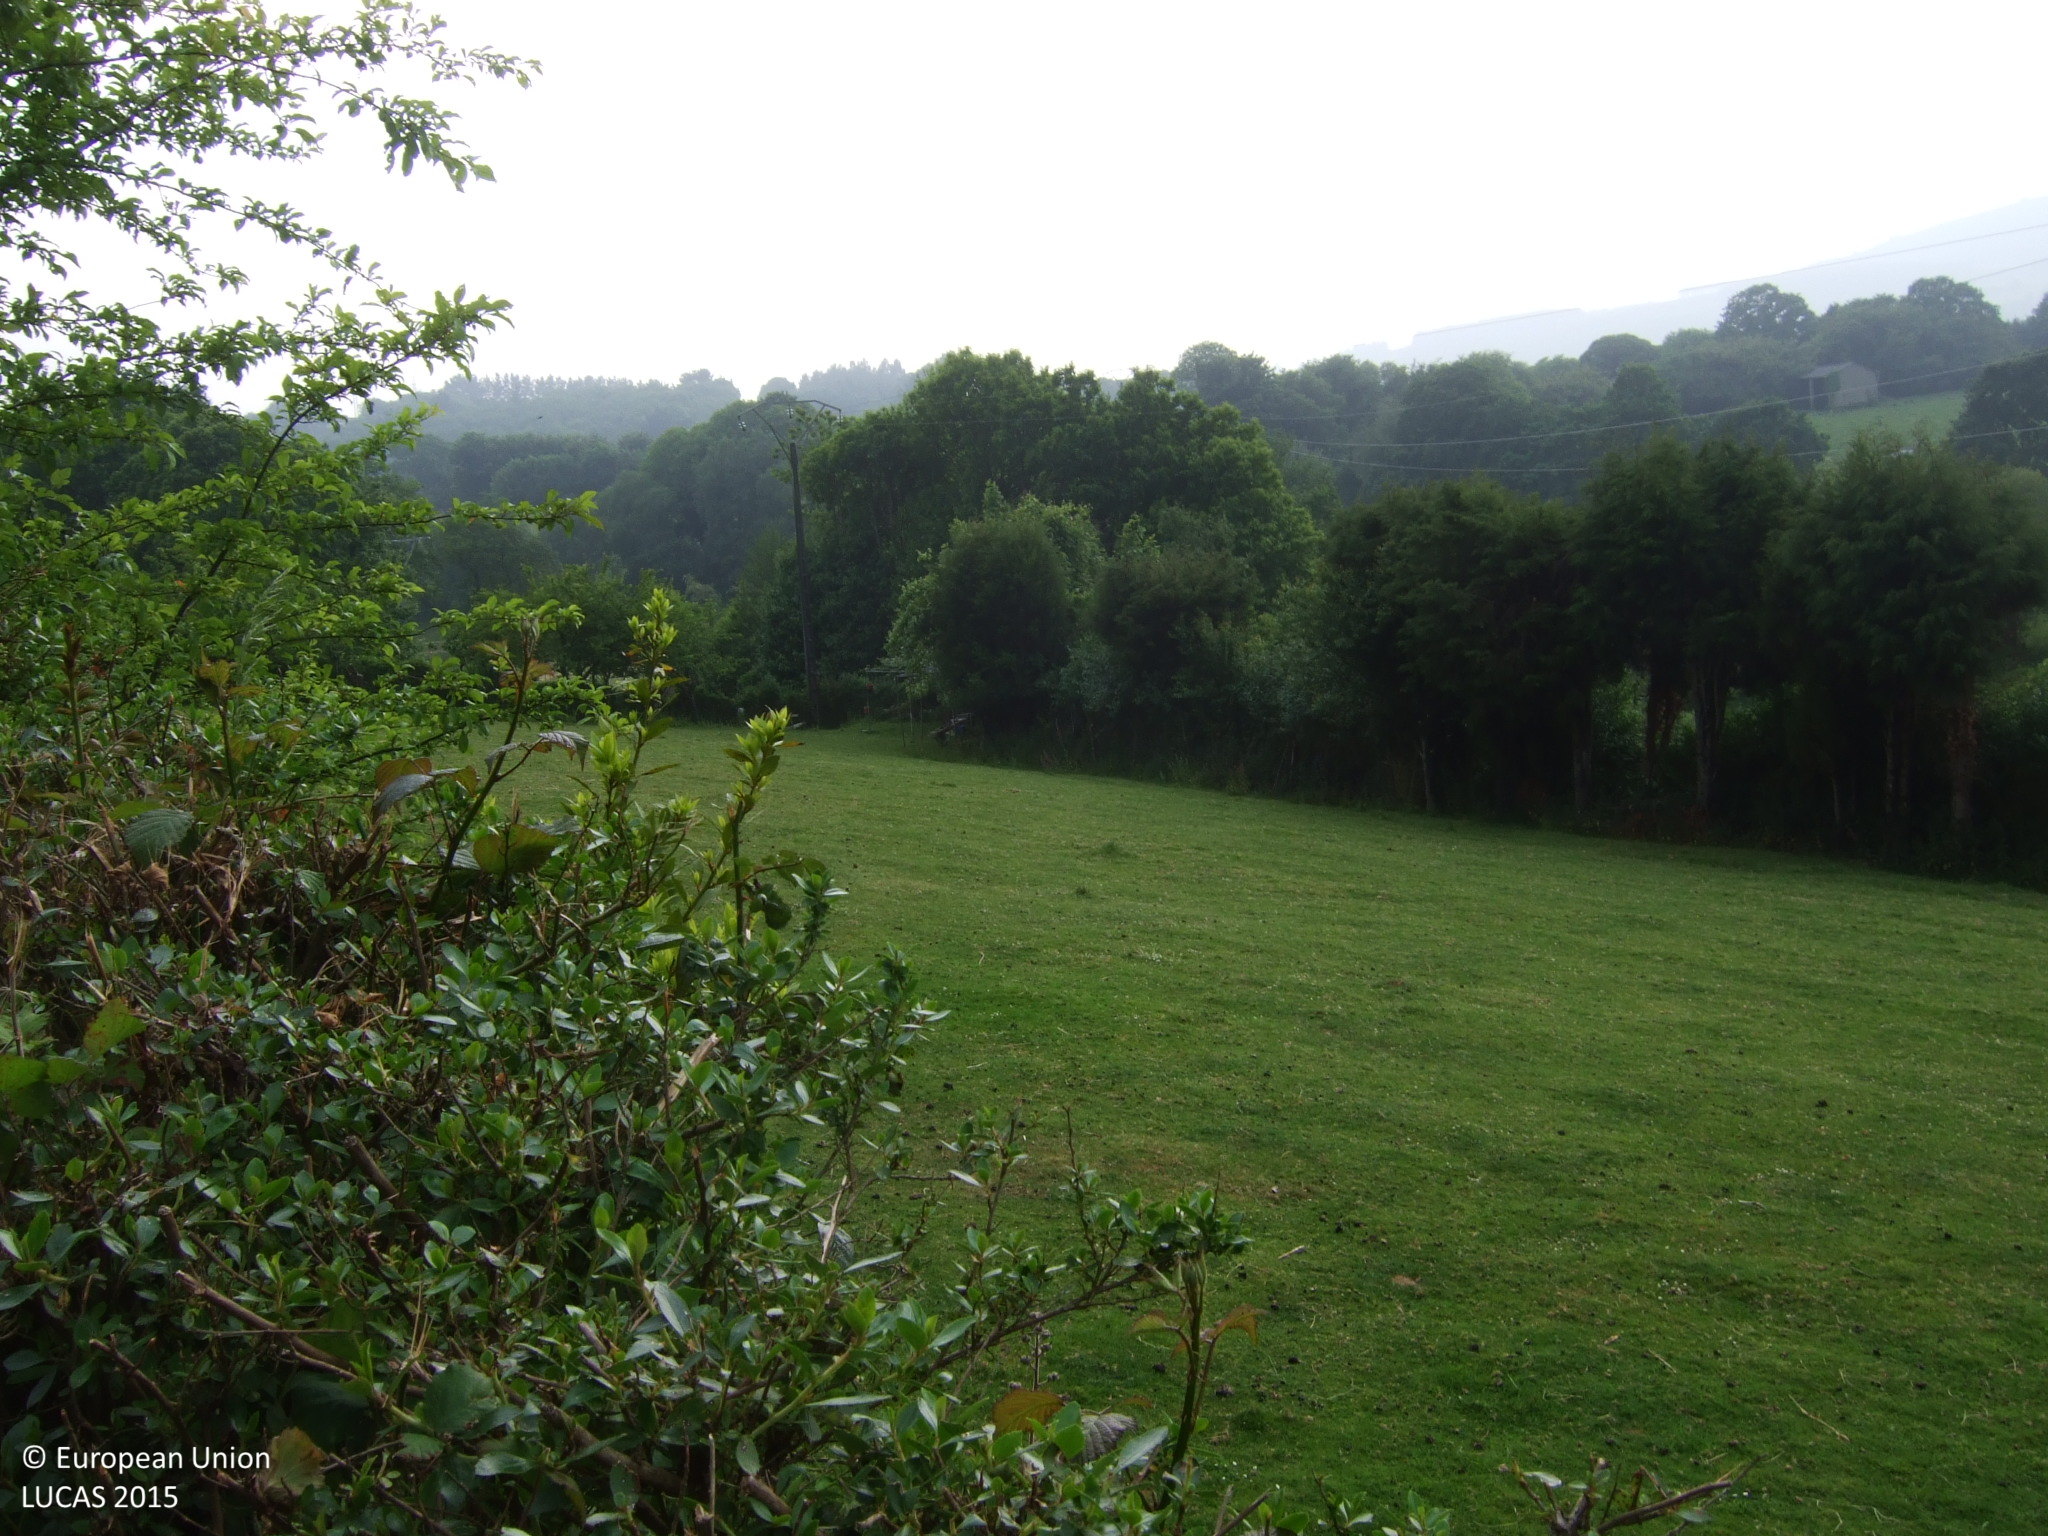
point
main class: Grassland
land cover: Grassland without tree/shrub cover
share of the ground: > 75 %
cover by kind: herbaceous plants 100 %
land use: Agriculture (excluding fallow land and kitchen gardens)
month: June
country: ES
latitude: 43.3706
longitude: -7.4678
